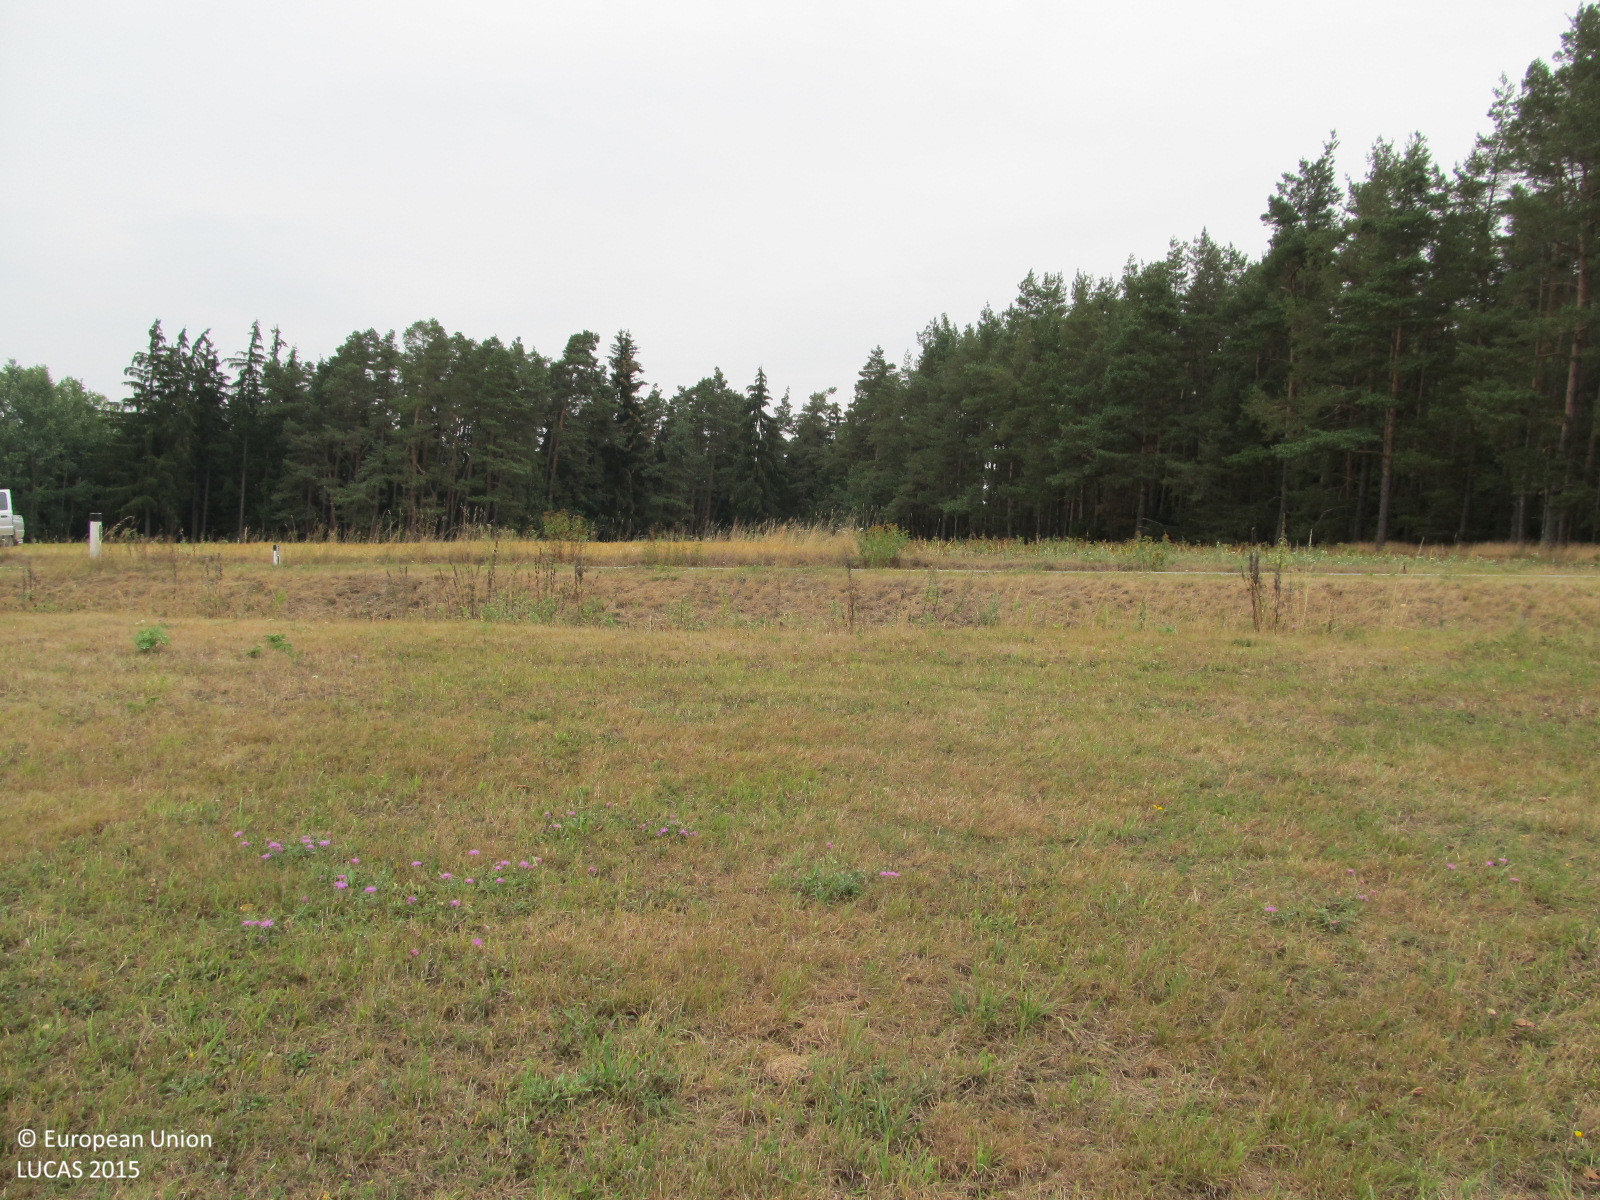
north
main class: Grassland
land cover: Grassland without tree/shrub cover
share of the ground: > 75 %
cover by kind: herbaceous plants 100 %
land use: Agriculture (excluding fallow land and kitchen gardens)
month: August
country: AT
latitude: 48.9363
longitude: 15.4501
